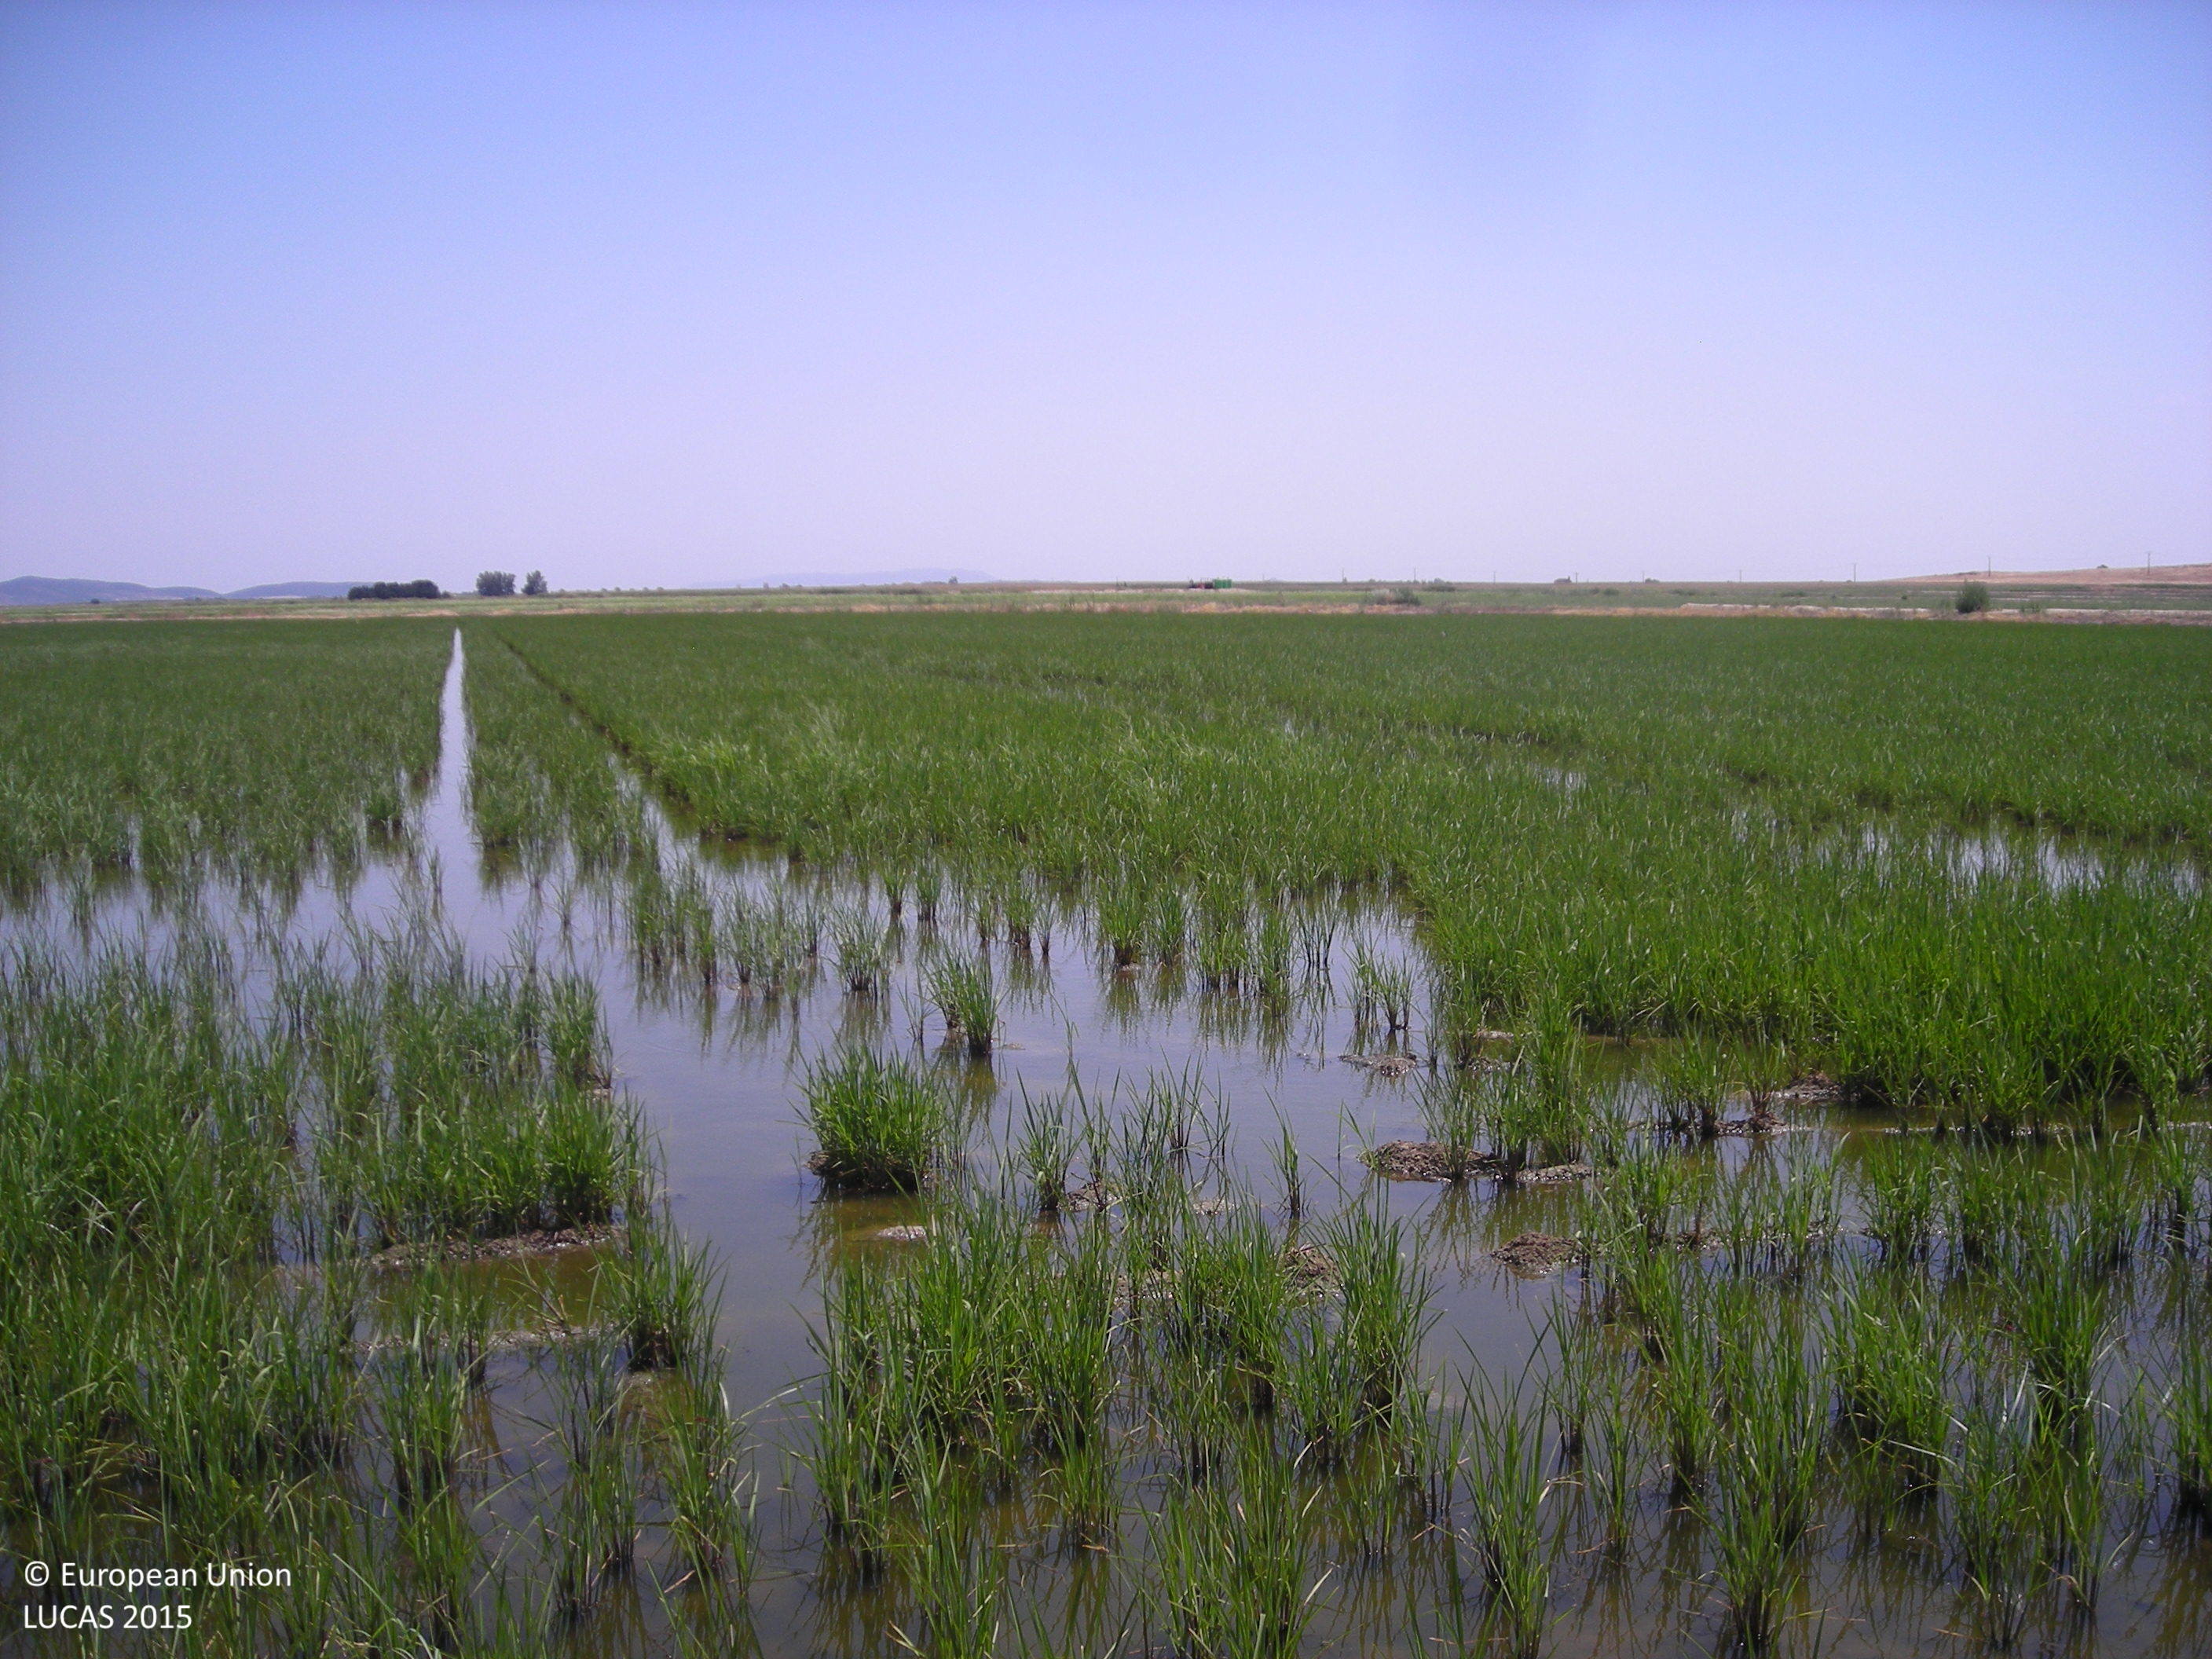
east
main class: Cropland
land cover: Rice
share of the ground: > 75 %
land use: Agriculture (excluding fallow land and kitchen gardens)
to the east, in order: Rice; Grass margins; Tracks; Grass margins; Ditches and canals; Tomatoes; Grass margins; Rice
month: July
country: ES
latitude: 39.0215
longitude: -5.9803
